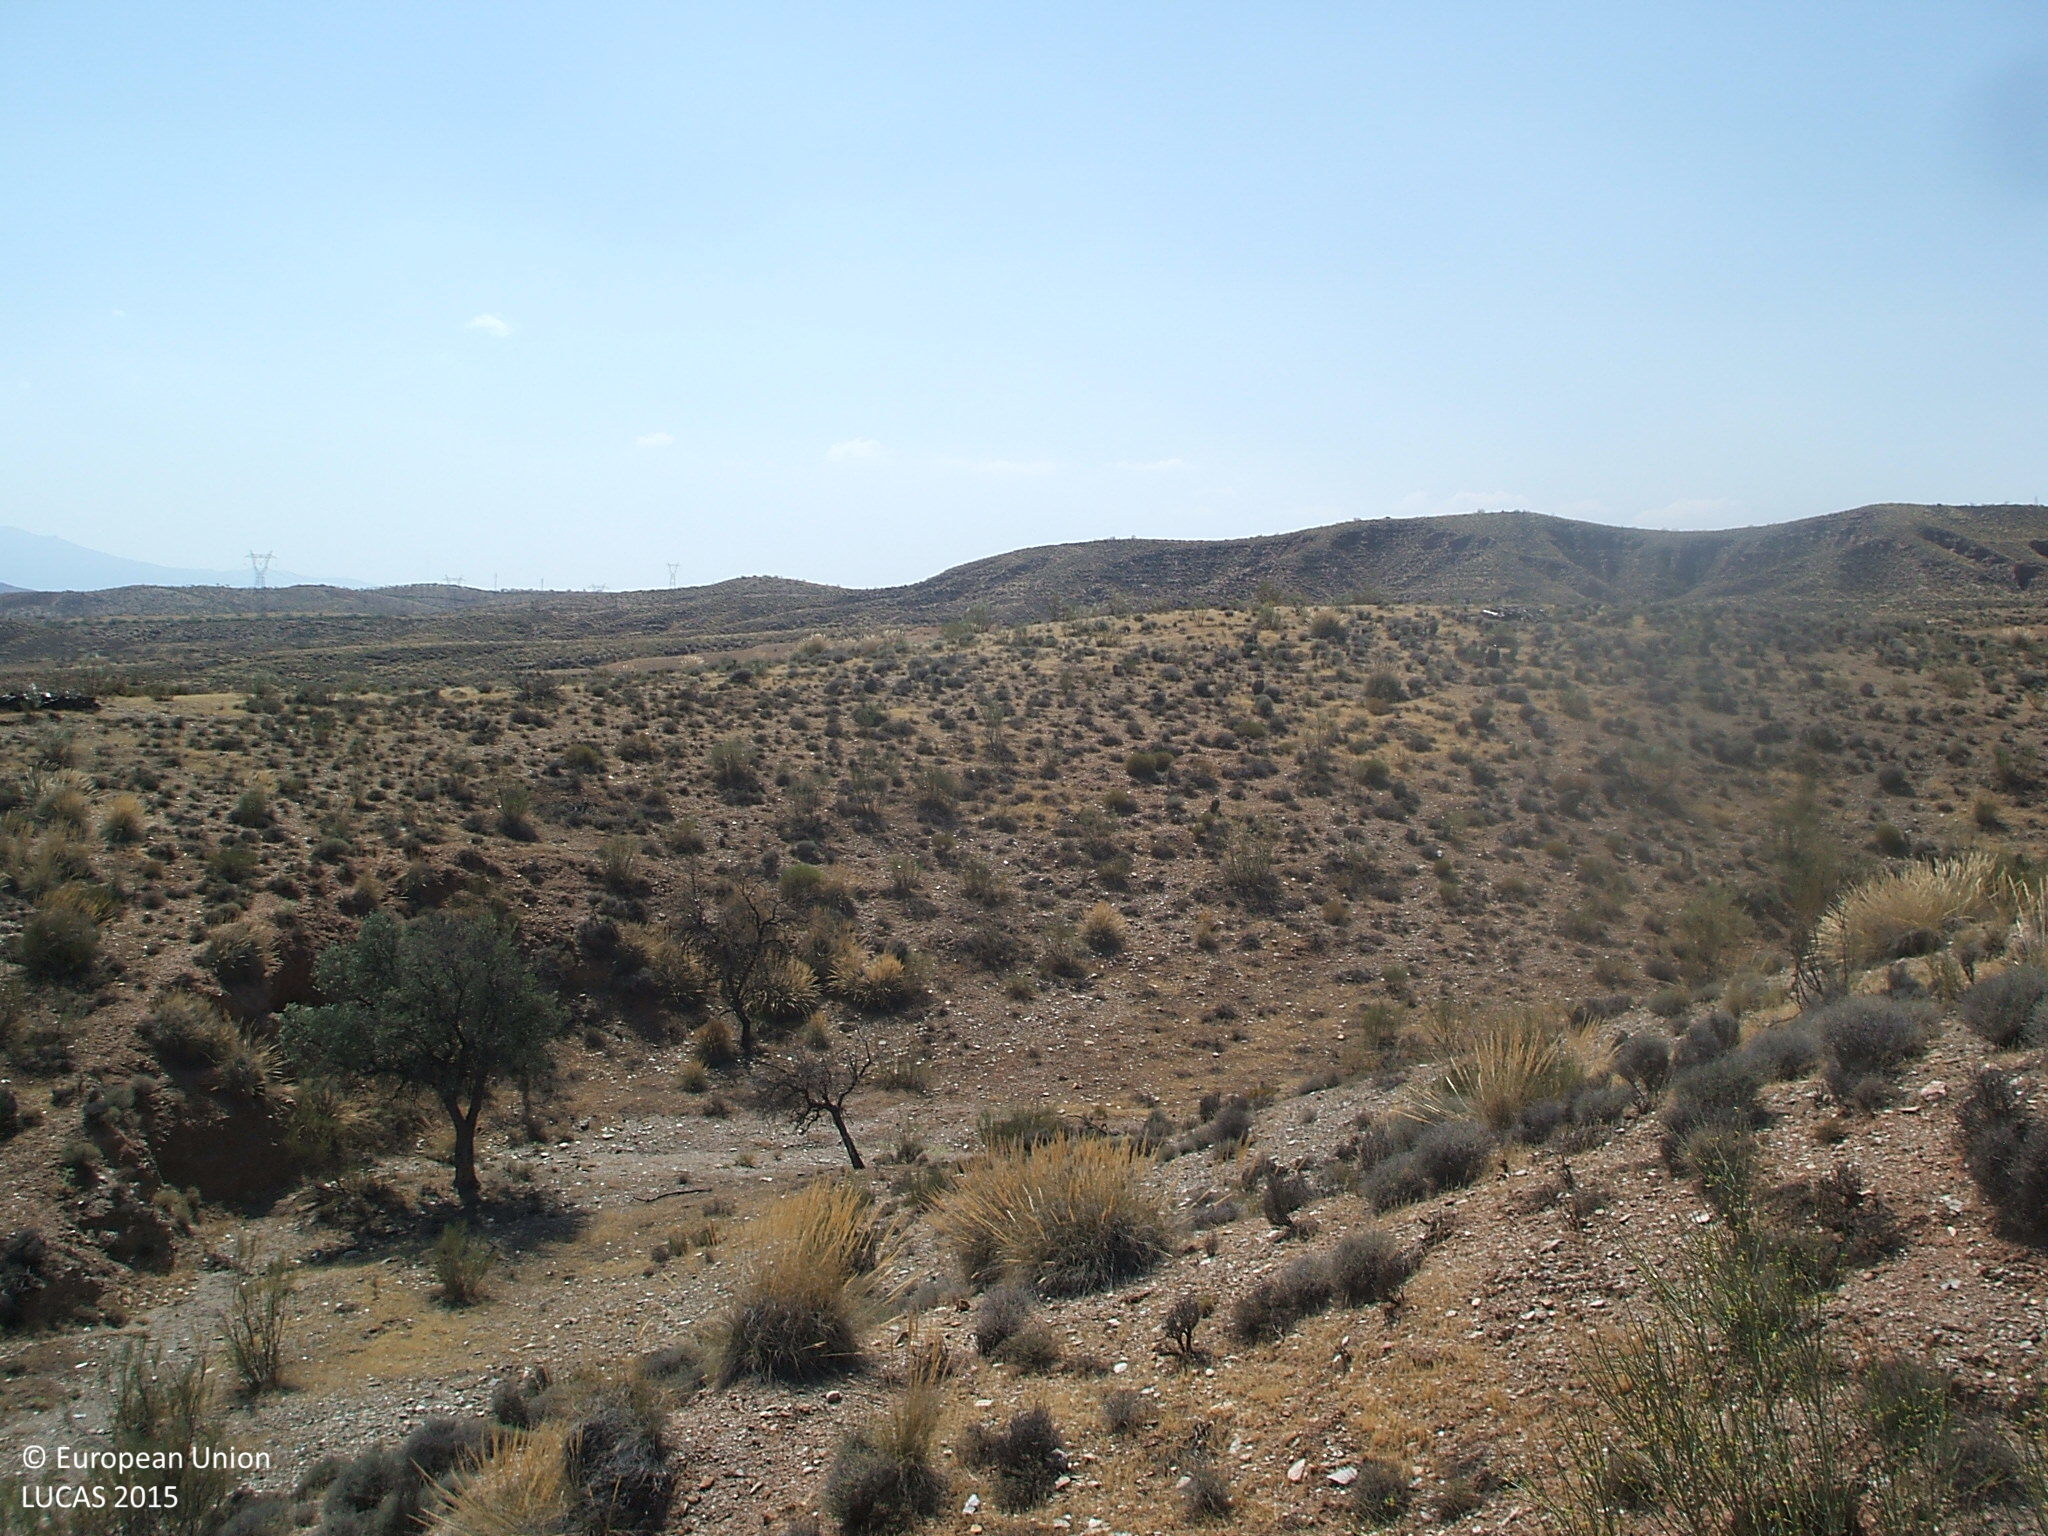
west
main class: Shrubland
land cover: Shrubland without tree cover
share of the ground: 50 - 75 %
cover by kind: shrubs 60 %, consolidated bare surface 40 %
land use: Semi-natural and natural areas not in use
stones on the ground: > 50 %
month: June
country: ES
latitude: 37.2004
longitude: -2.8611
